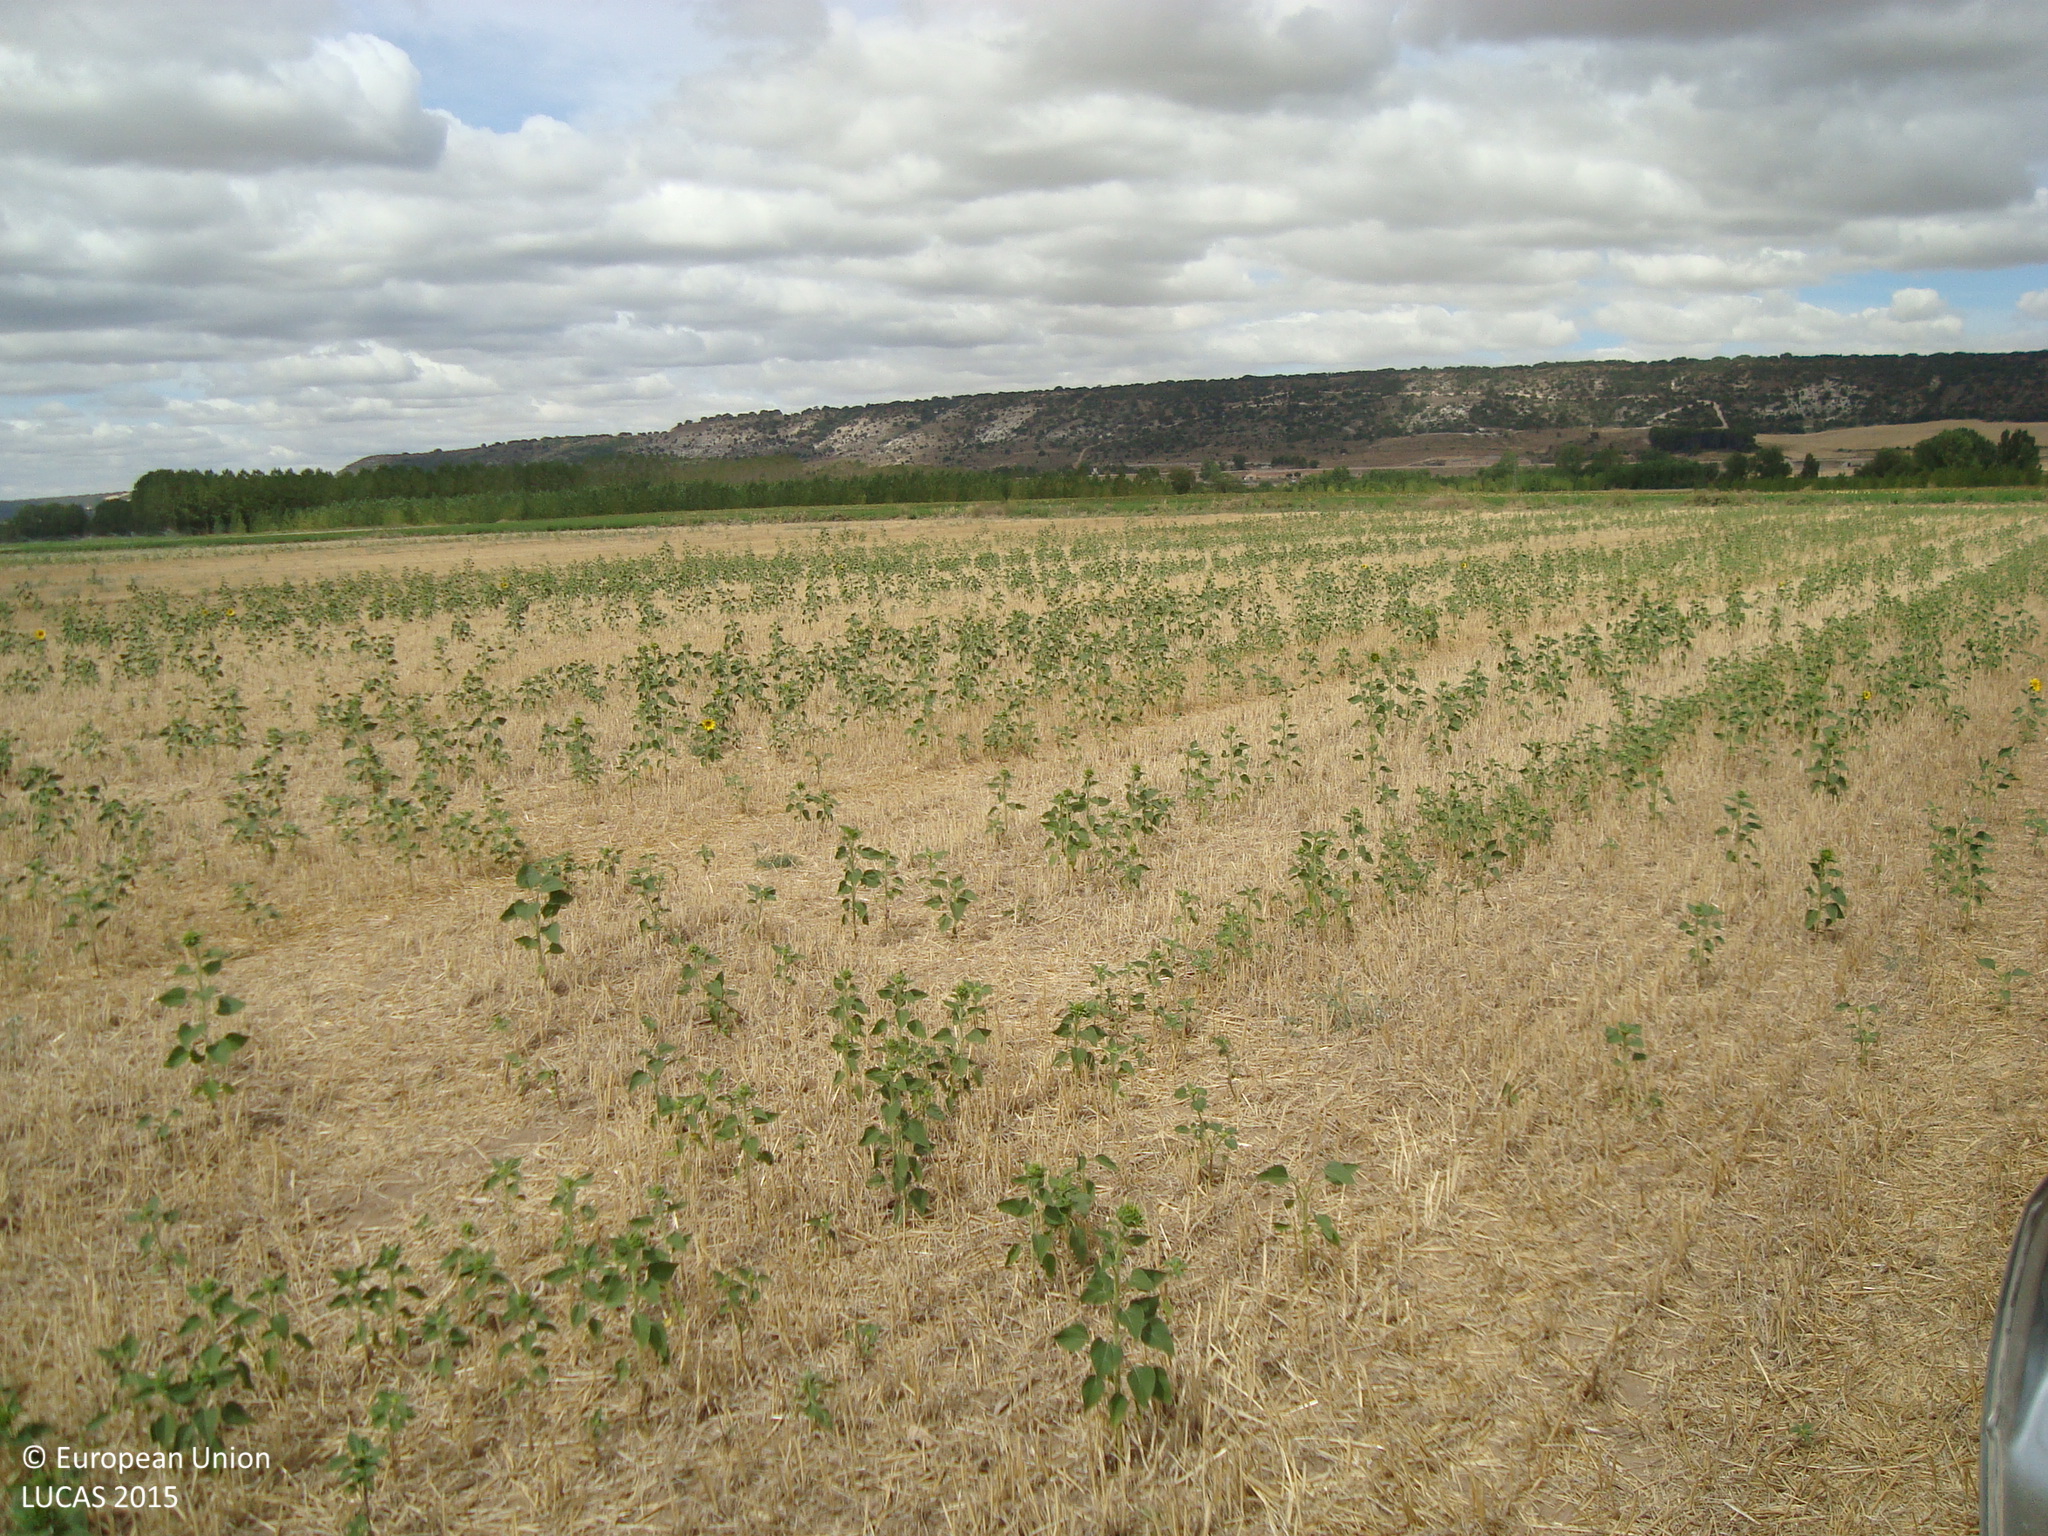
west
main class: Cropland
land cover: Common wheat
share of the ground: > 75 %
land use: Agriculture (excluding fallow land and kitchen gardens)
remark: Harvested field
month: August
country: ES
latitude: 42.1154
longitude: -4.1308
